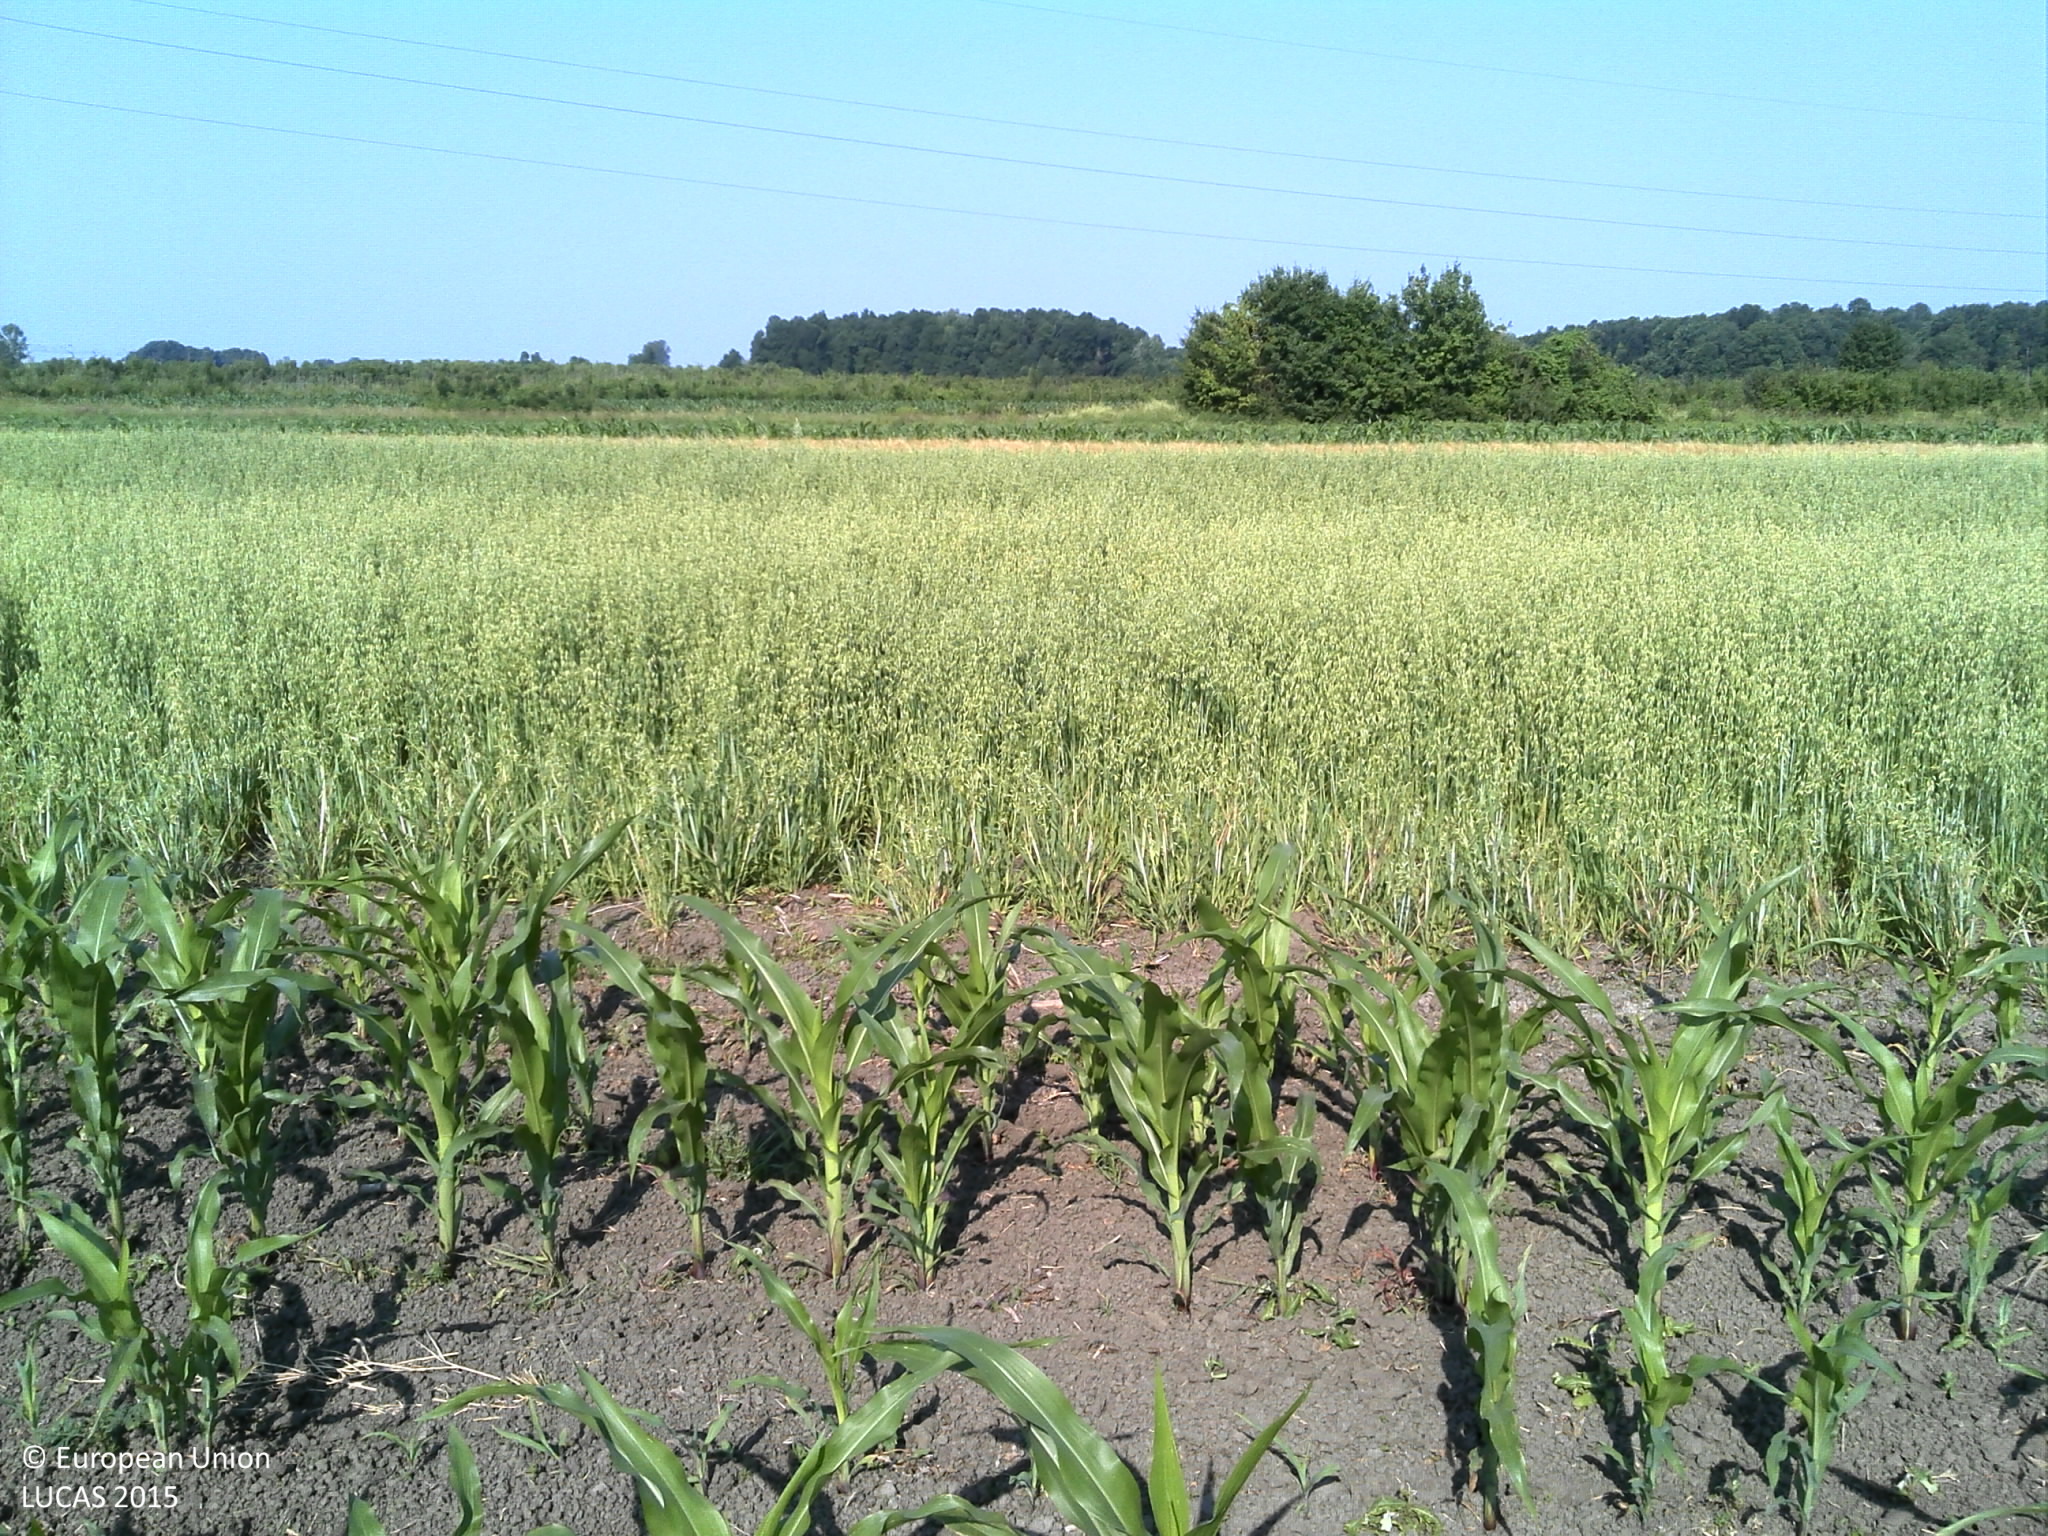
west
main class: Cropland
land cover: Maize
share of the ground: 25 - 50 %
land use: Agriculture (excluding fallow land and kitchen gardens)
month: June
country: HR
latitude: 45.2376
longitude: 18.4507
